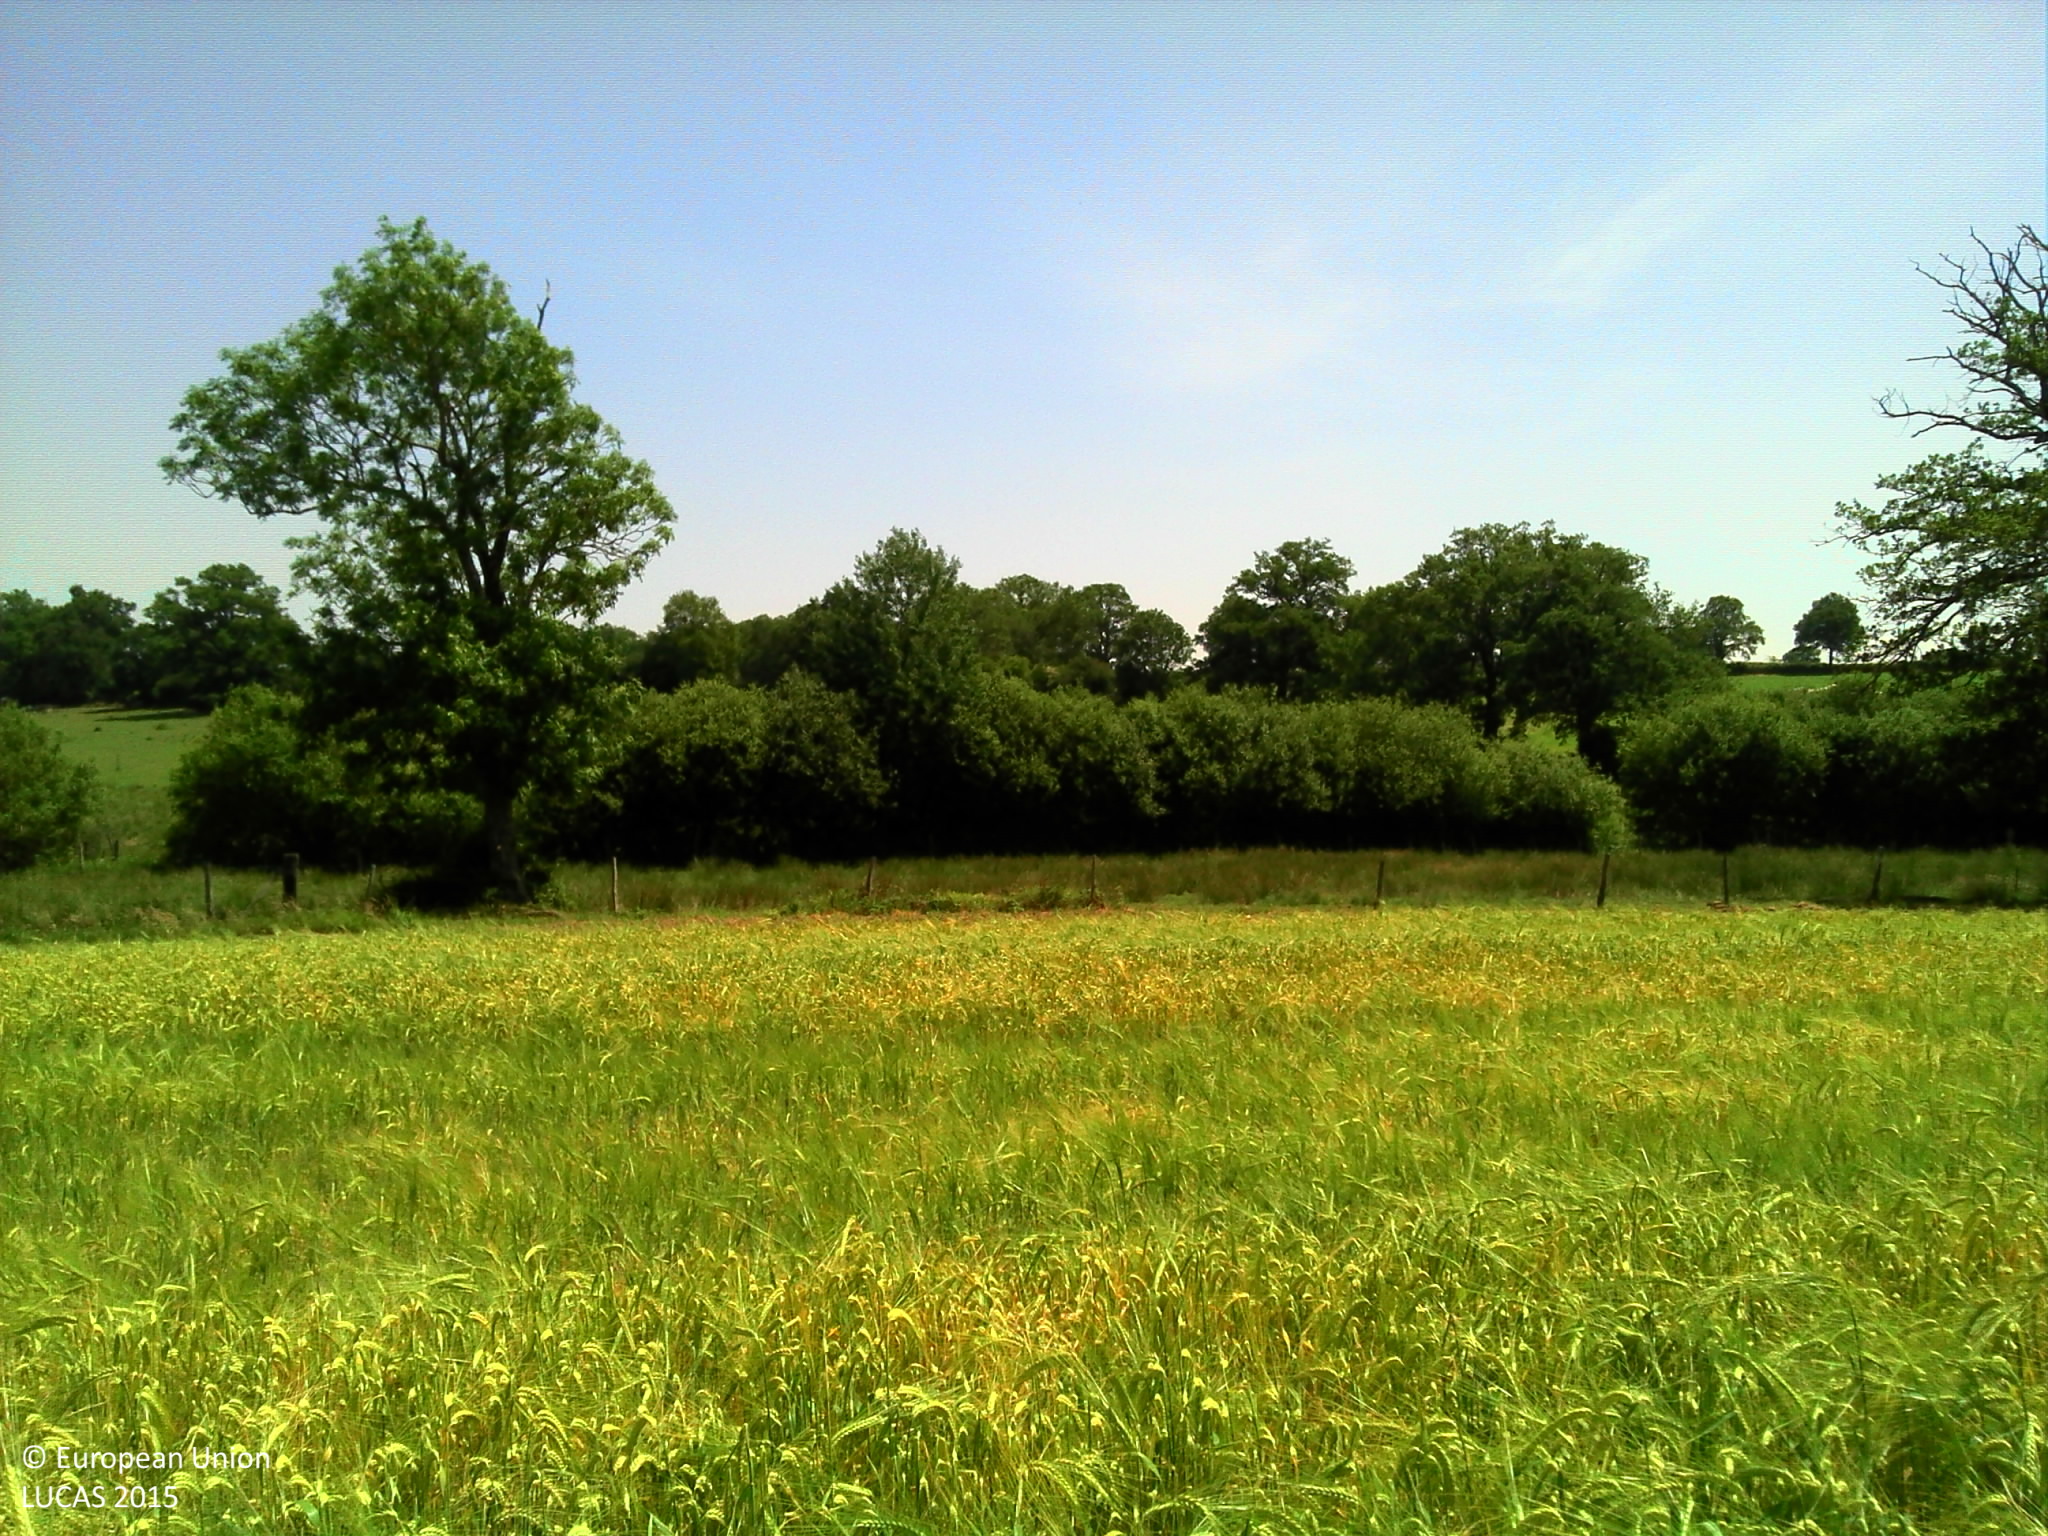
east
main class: Cropland
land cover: Barley
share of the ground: > 75 %
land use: Agriculture (excluding fallow land and kitchen gardens)
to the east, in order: Barley; Fences; Grassland without tree/shrub cover; Fences; Rivers and streams; Lines of trees; Grassland without tree/shrub cover; Fences; Managed hedges; Grassland without tree/shrub cover
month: June
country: FR
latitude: 46.3597
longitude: 3.0444
